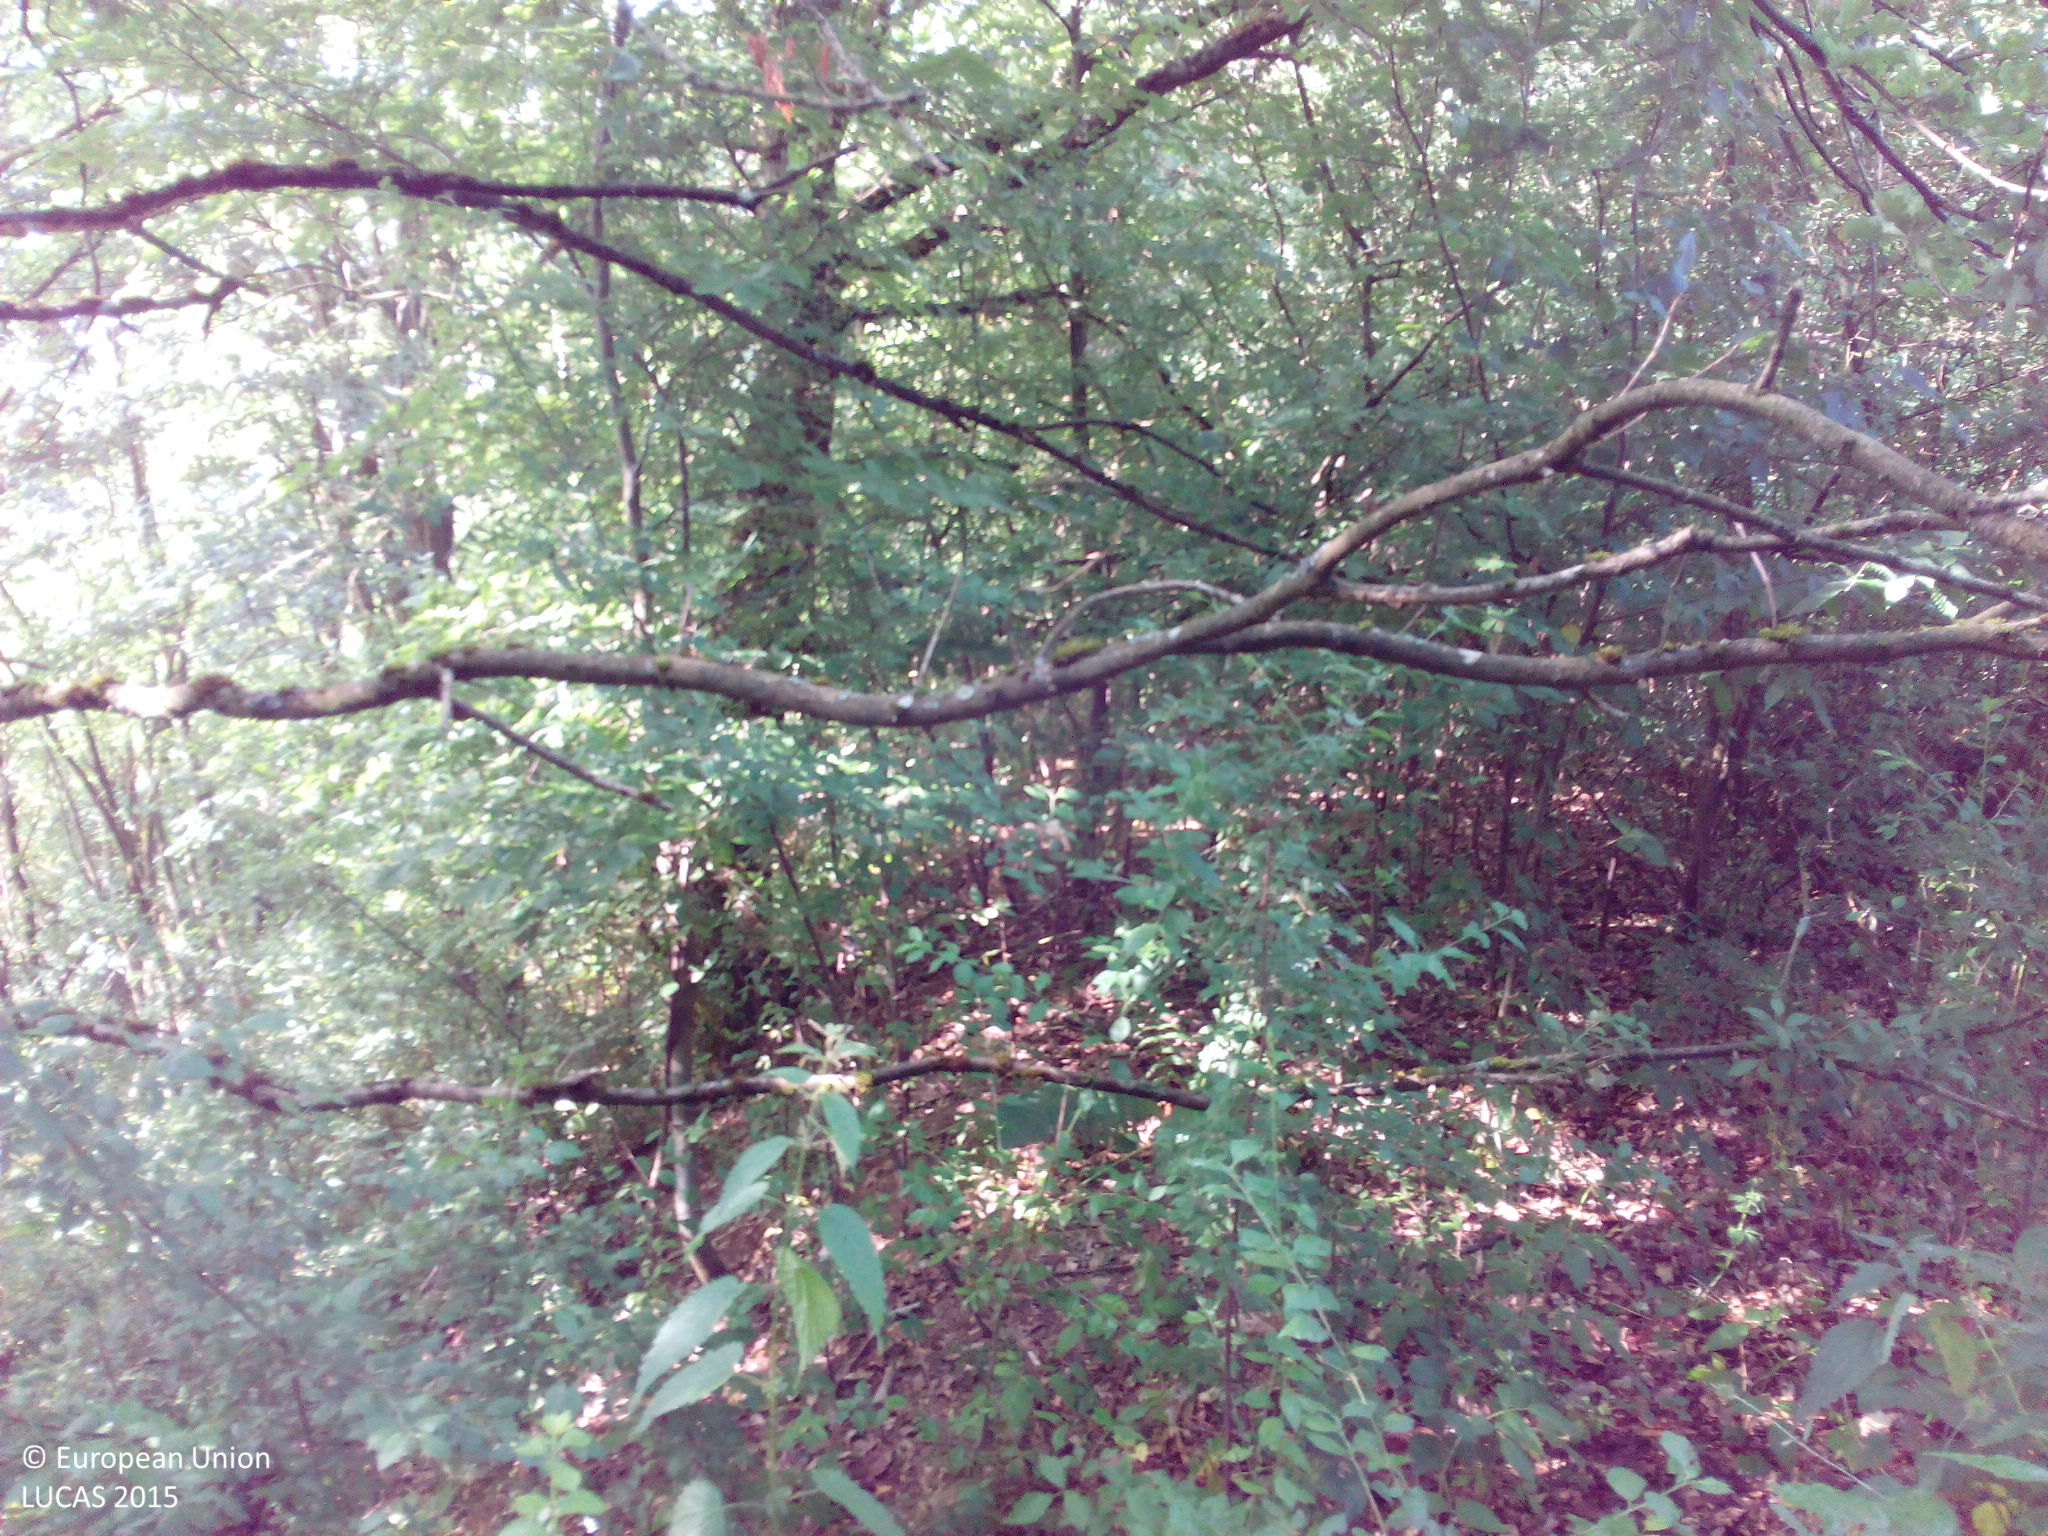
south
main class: Woodland
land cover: Broadleaved woodland
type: mesophytic deciduous forest
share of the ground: > 75 %
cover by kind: broadleaved forest trees 100 %
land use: Forestry
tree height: > 5 m
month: July
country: DE
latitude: 49.4467
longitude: 7.1452
